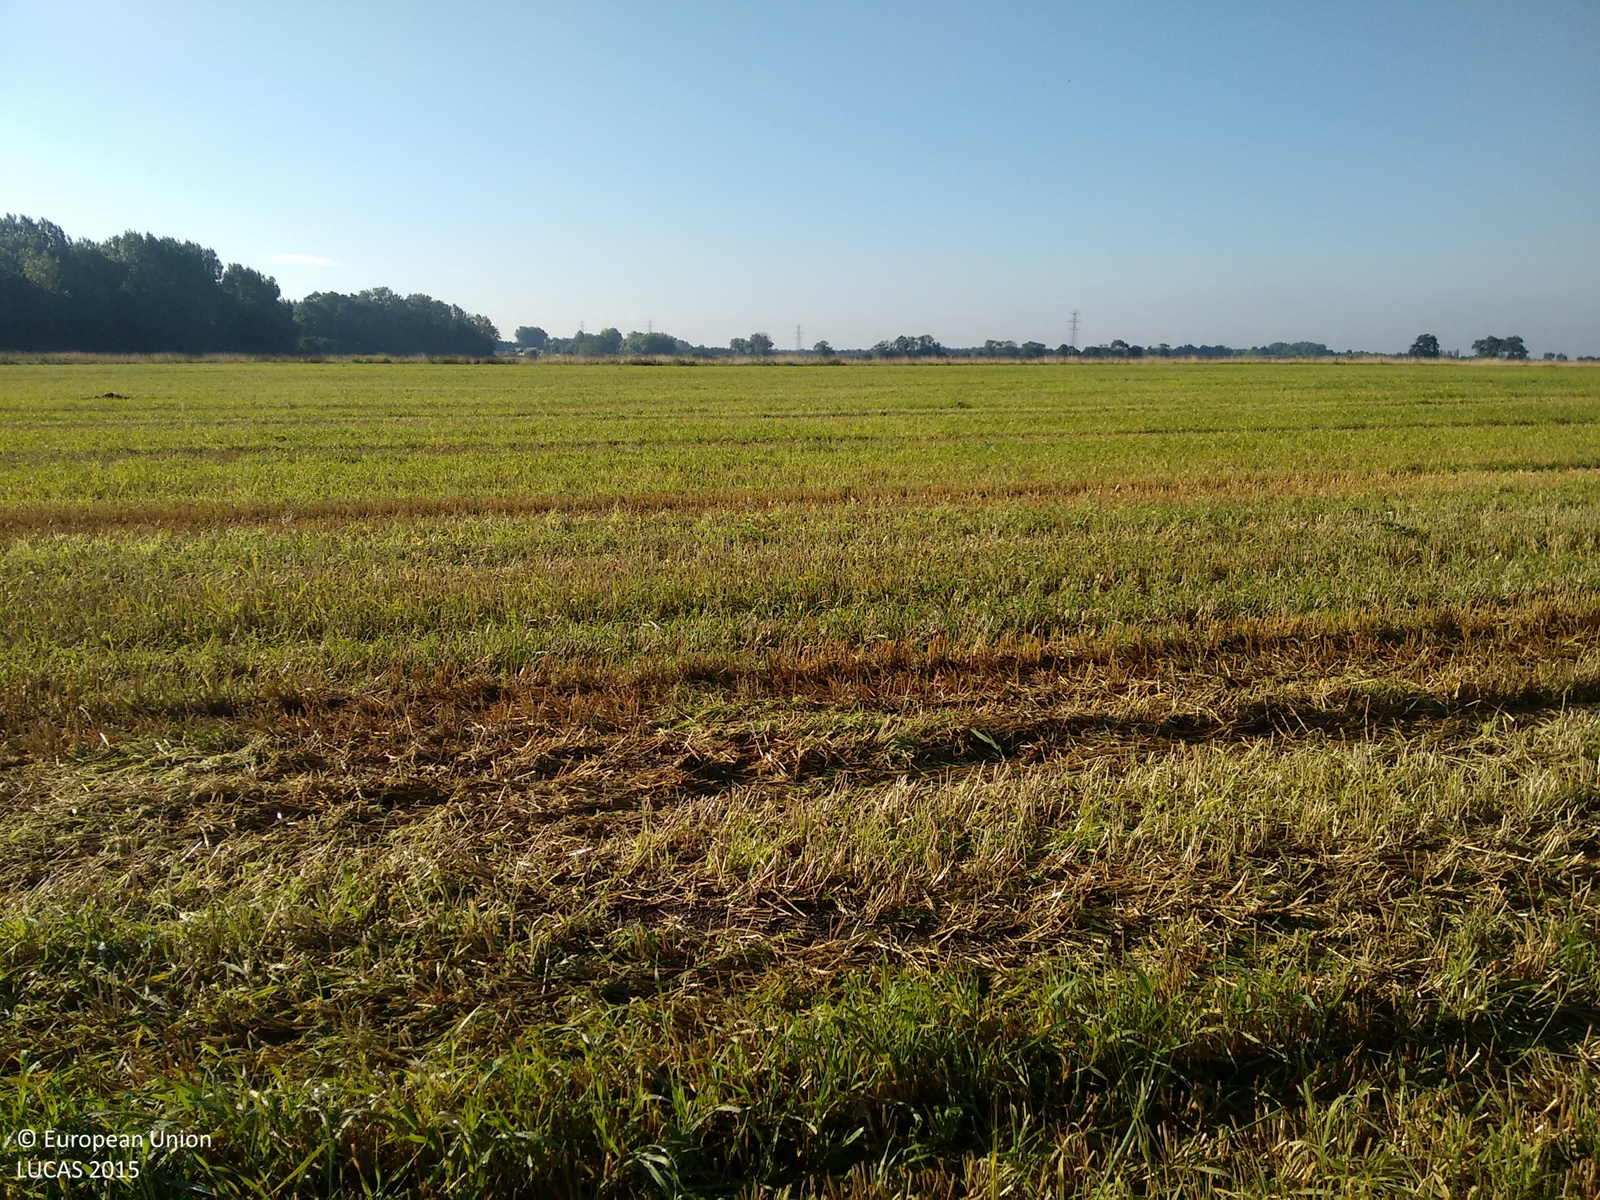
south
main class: Cropland
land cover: Barley
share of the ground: > 75 %
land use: Agriculture (excluding fallow land and kitchen gardens)
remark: Harvested field
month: September
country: GB
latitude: 52.2251
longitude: 0.2049
